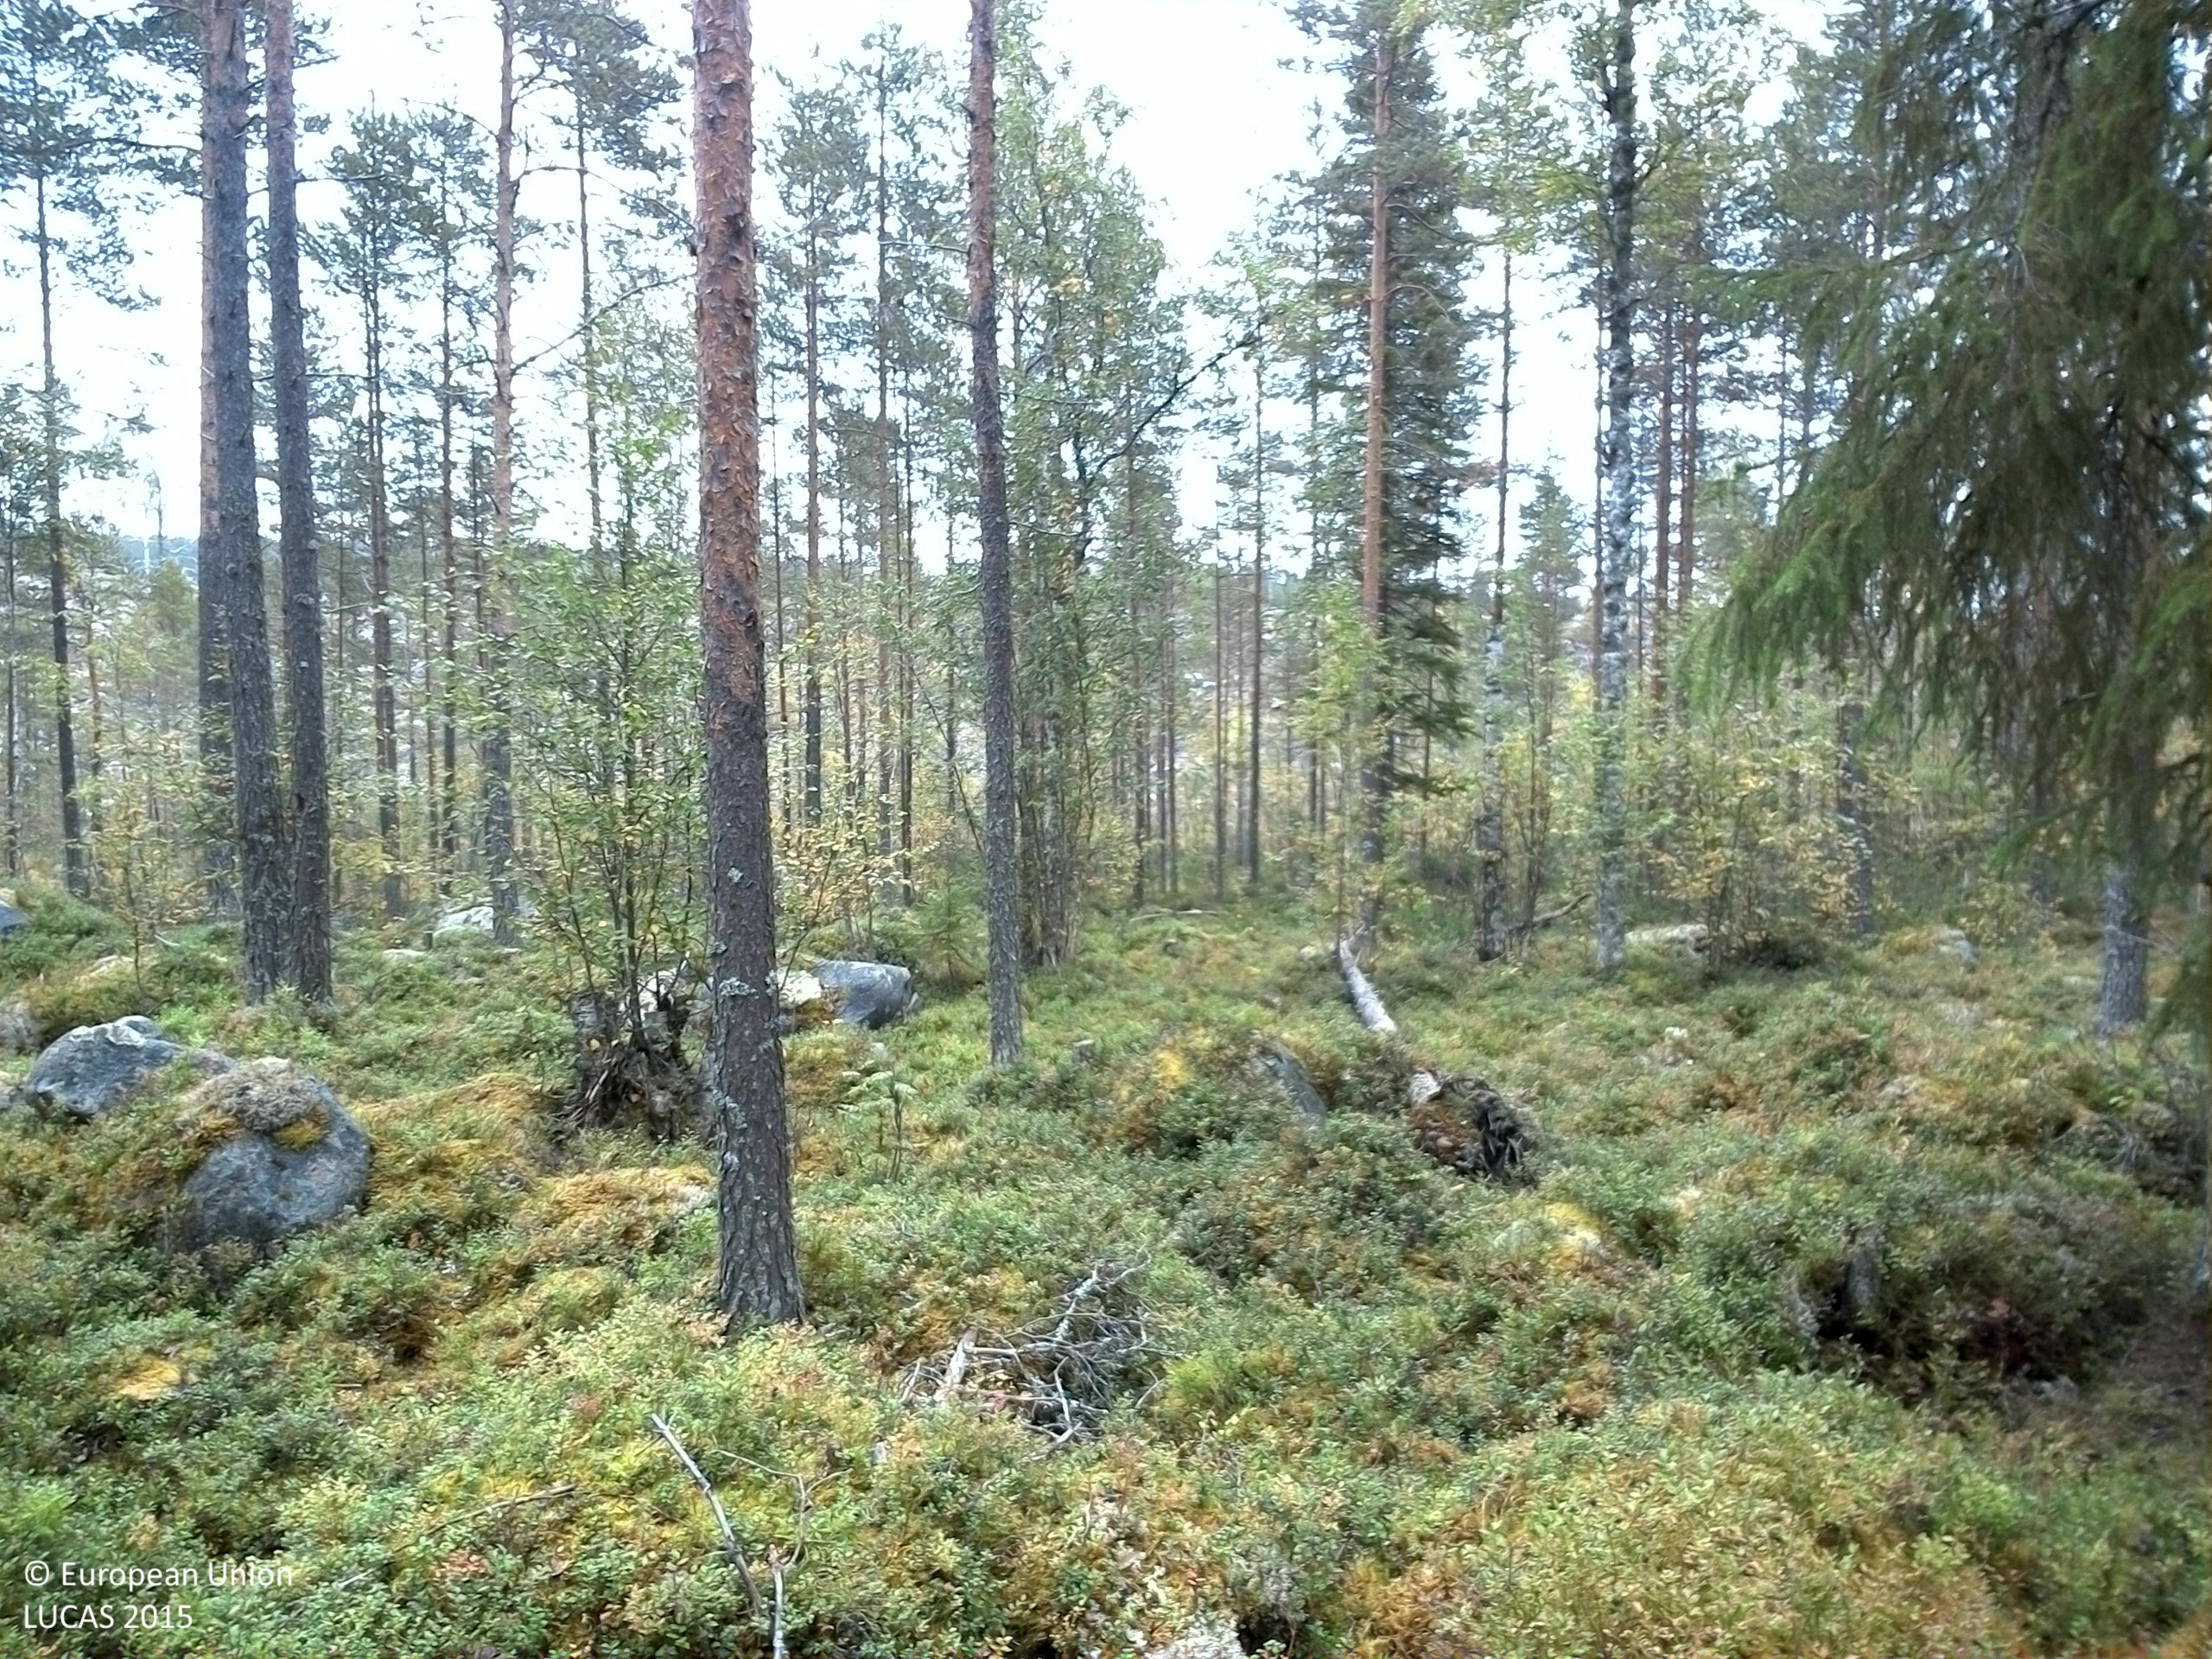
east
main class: Woodland
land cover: Pine dominated mixed woodland
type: boreal forest
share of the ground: 50 - 75 %
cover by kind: coniferous forest trees 40 %, shrubs 25 %, broadleaved forest trees 20 %, lichens and mosses 10 %, consolidated bare surface 5 %
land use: Forestry
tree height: > 5 m
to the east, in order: Pine dominated mixed woodland; Pine dominated coniferous woodland; Inland fresh water bodies; Shrubland with sparse tree cover; Rivers and streams; Other mixed woodland
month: September
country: SE
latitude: 61.6602
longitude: 15.0635
